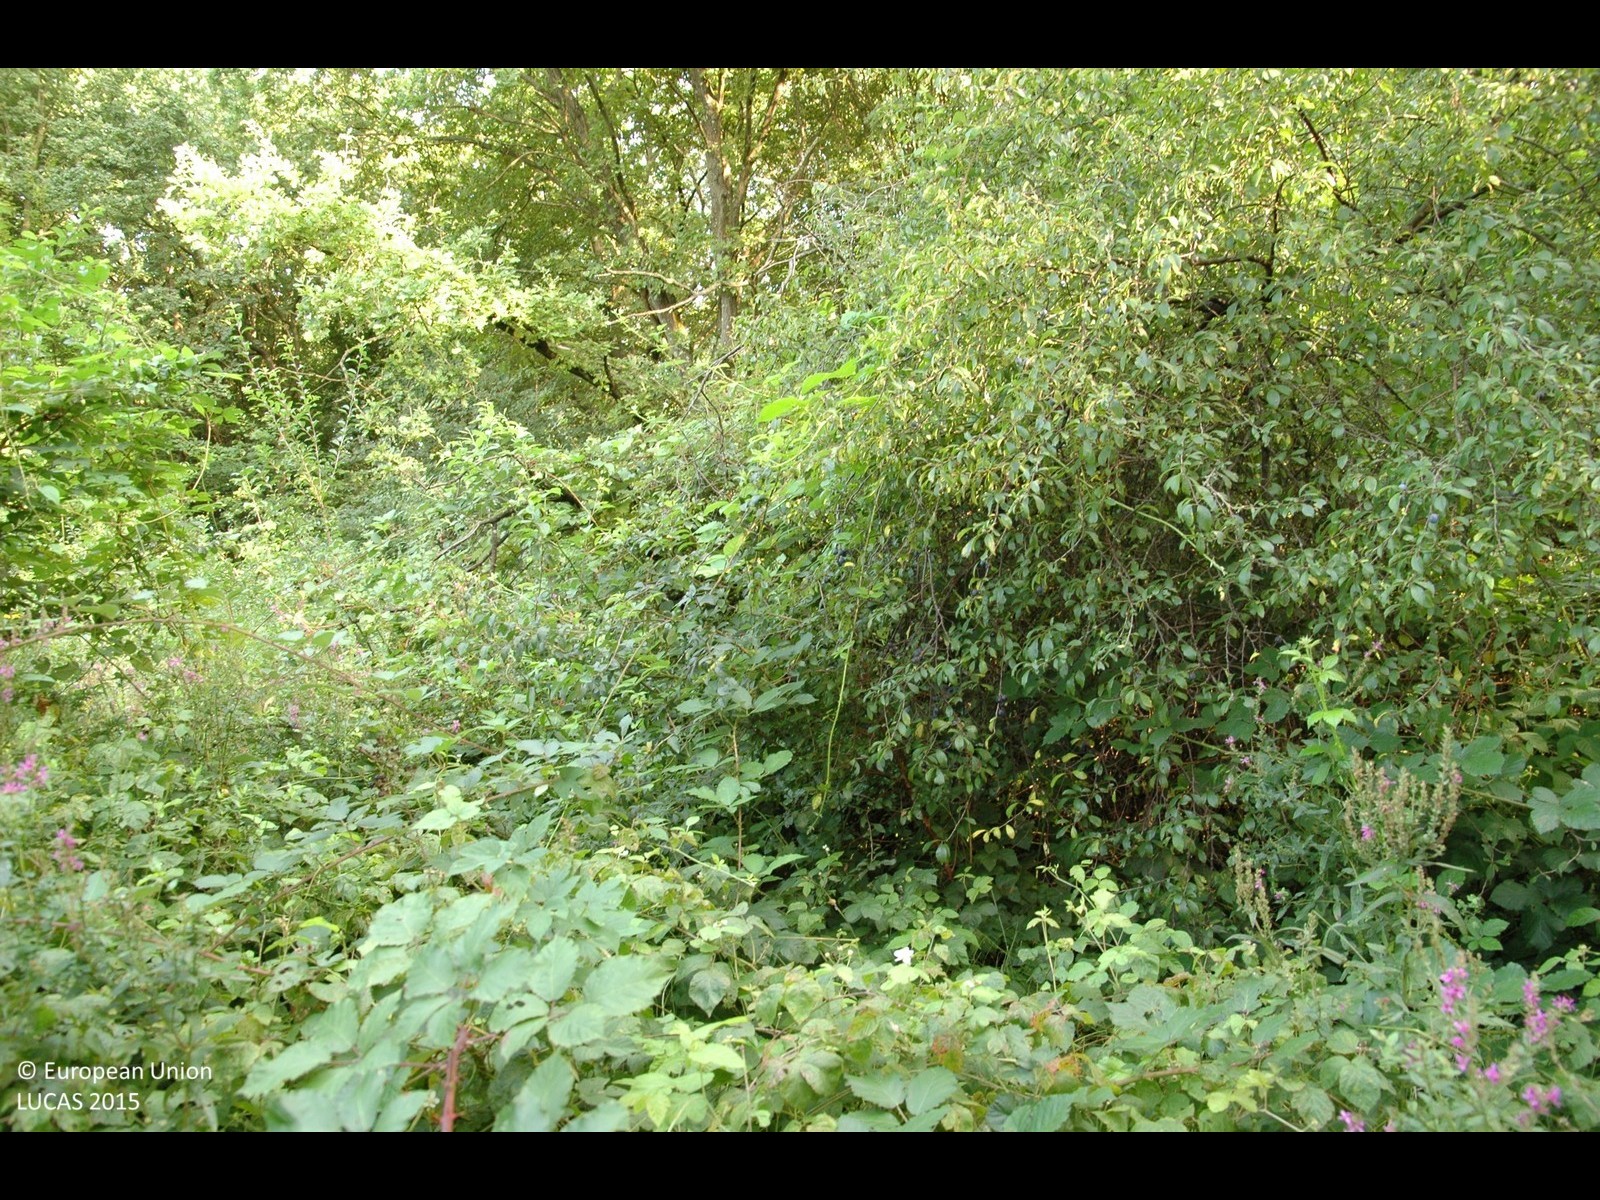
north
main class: Shrubland
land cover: Shrubland with sparse tree cover
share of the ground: > 75 %
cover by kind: shrubs 95 %, broadleaved forest trees 5 %
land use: Semi-natural and natural areas not in use
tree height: > 5 m
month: August
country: HR
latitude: 45.8152
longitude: 16.1113
